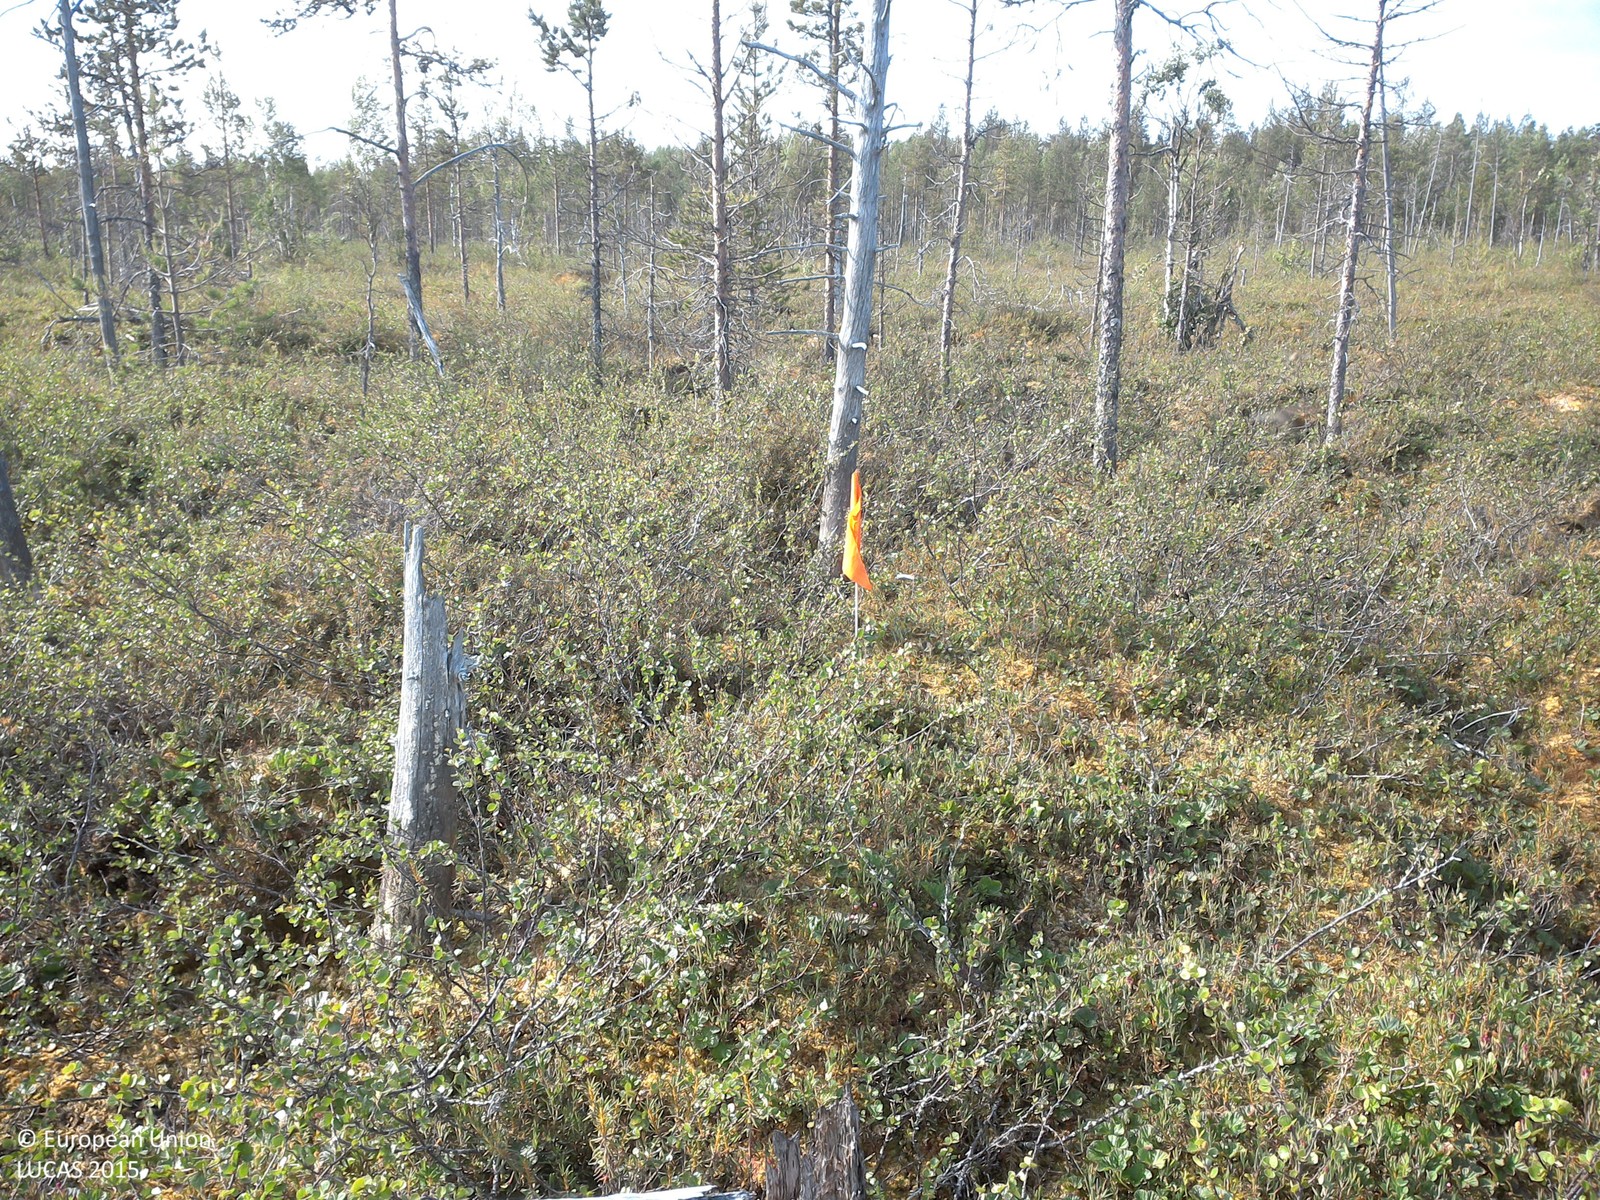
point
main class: Woodland
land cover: Pine dominated coniferous woodland
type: boreal forest
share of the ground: 10 - 25 %
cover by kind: shrubs 40 %, lichens and mosses 30 %, herbaceous plants 20 %, coniferous forest trees 10 %
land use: Amenities, museums, leisure
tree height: < 5 m
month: July
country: SE
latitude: 66.9497
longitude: 22.9939
